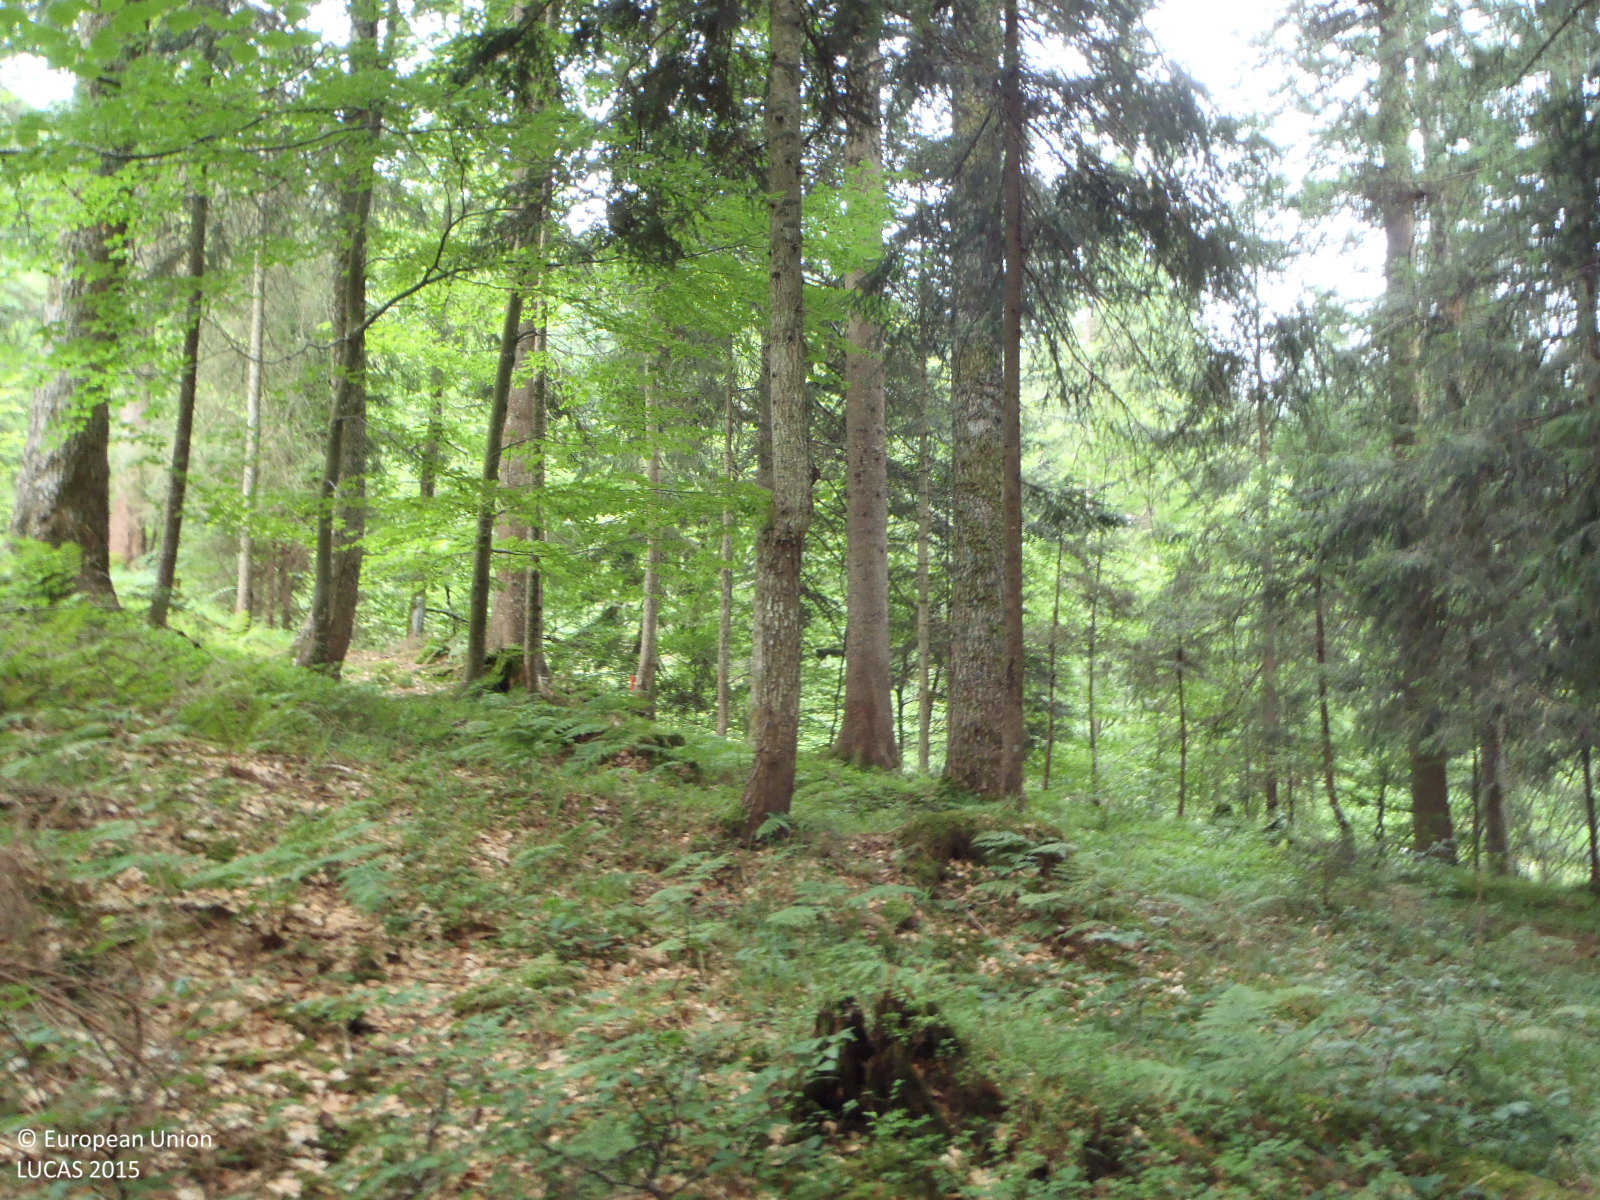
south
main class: Woodland
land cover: Spruce dominated mixed woodland
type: alpine coniferous forest
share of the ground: > 75 %
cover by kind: coniferous forest trees 55 %, broadleaved forest trees 30 %, herbaceous plants 10 %, unconsolidated bare surface 5 %
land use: Forestry
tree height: > 5 m
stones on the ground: < 10 %
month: July
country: AT
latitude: 47.5036
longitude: 9.9867
